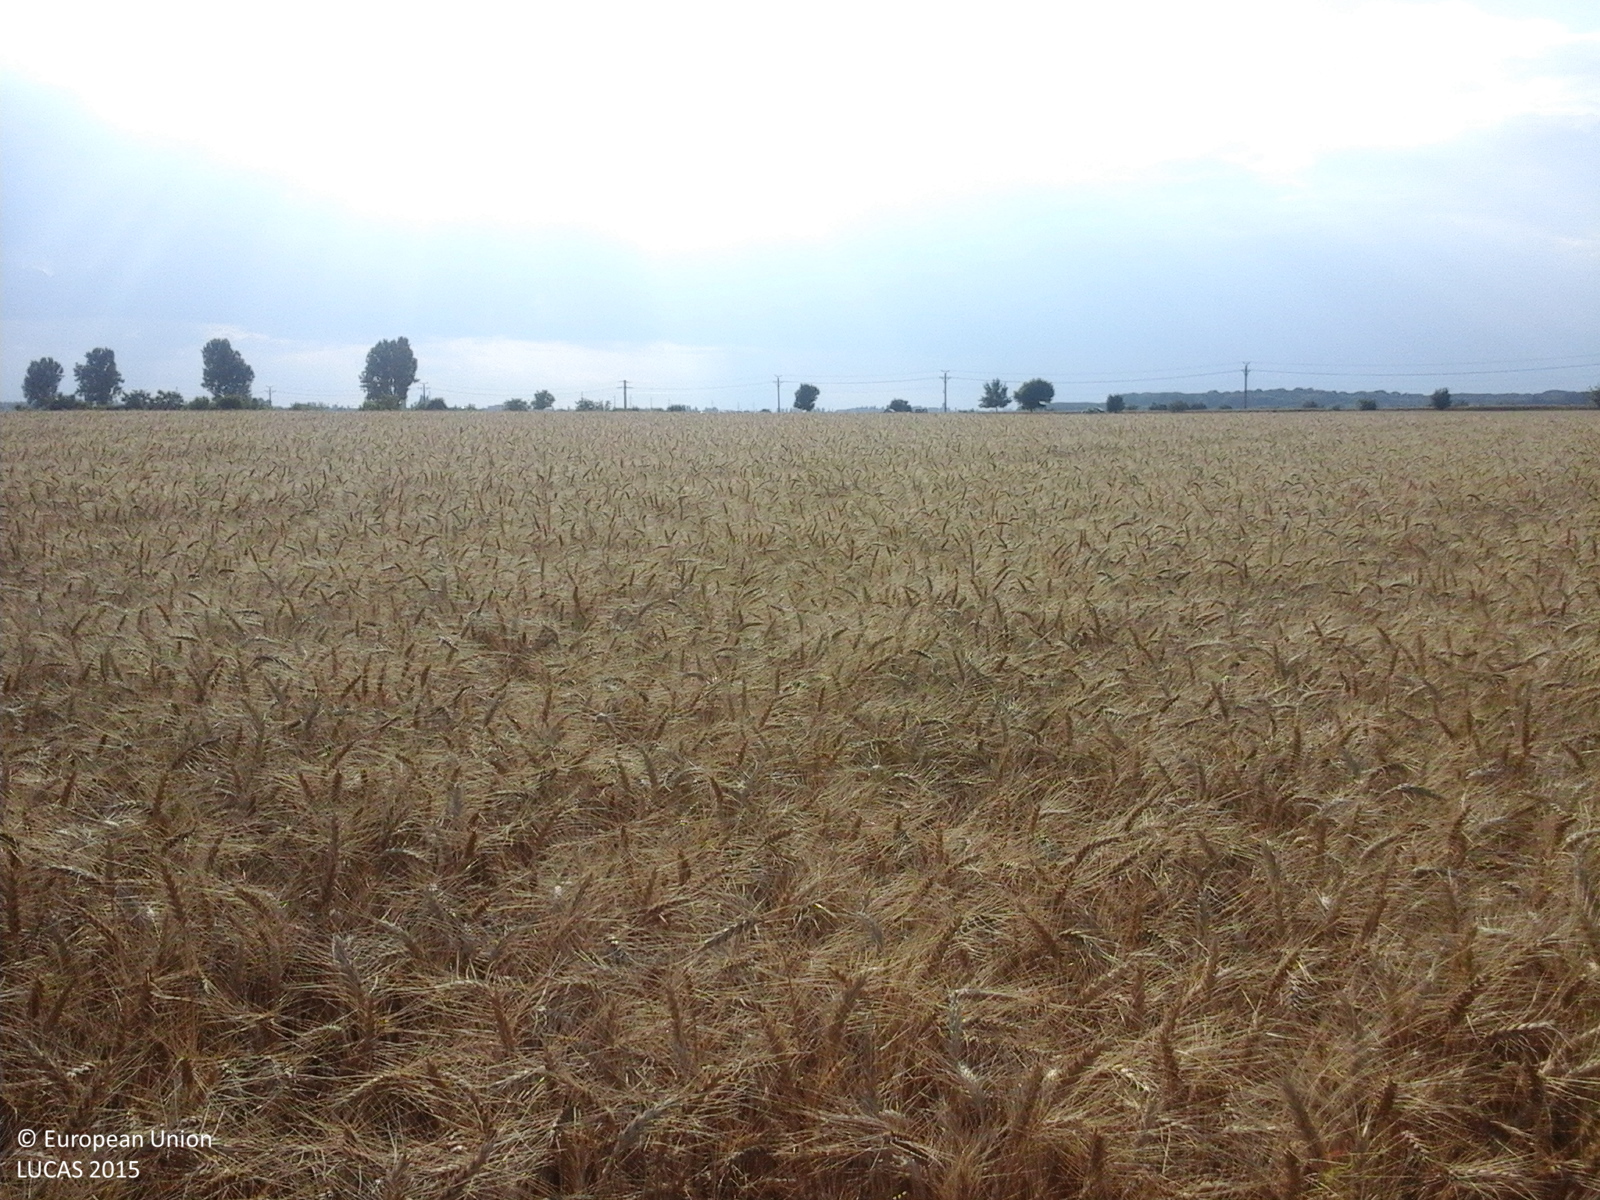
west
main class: Cropland
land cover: Common wheat
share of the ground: > 75 %
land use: Agriculture (excluding fallow land and kitchen gardens)
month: June
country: RO
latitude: 44.5707
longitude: 25.9824
